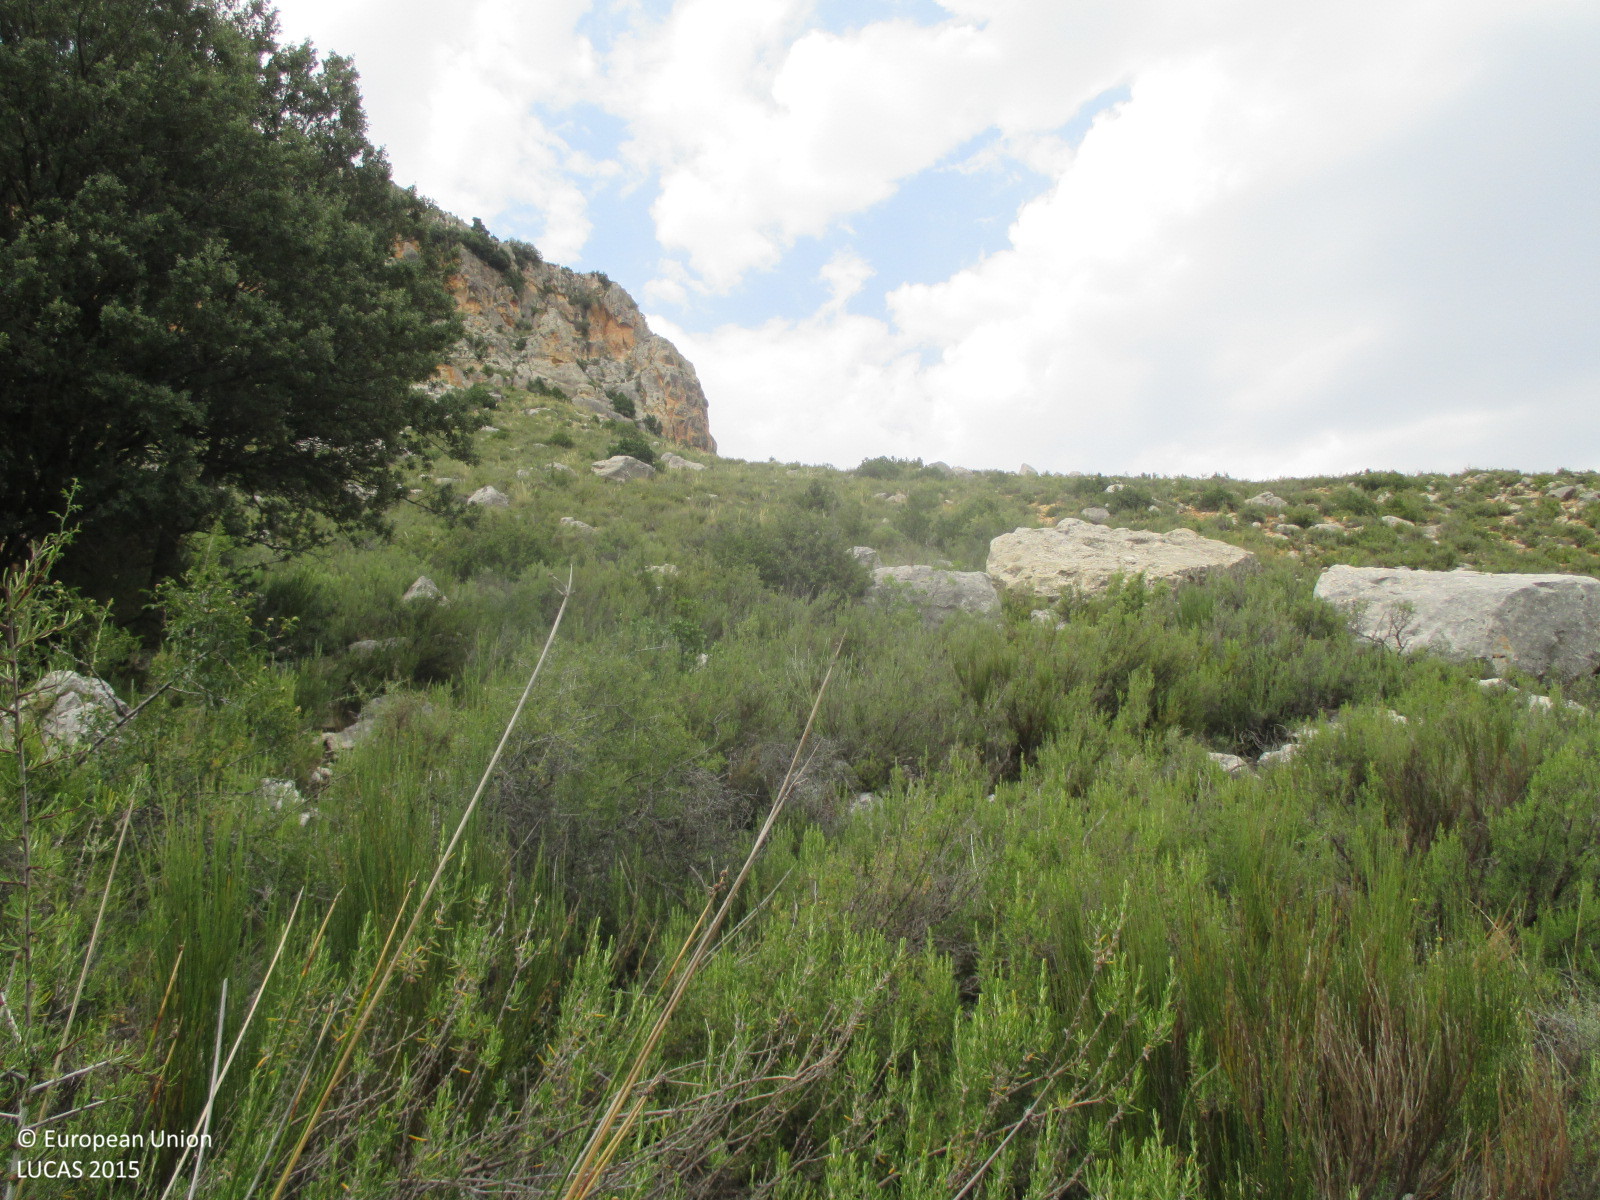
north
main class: Shrubland
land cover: Shrubland with sparse tree cover
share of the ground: > 75 %
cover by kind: shrubs 95 %, broadleaved forest trees 5 %
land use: Semi-natural and natural areas not in use
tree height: > 5 m
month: July
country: ES
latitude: 38.1480
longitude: -2.3512
